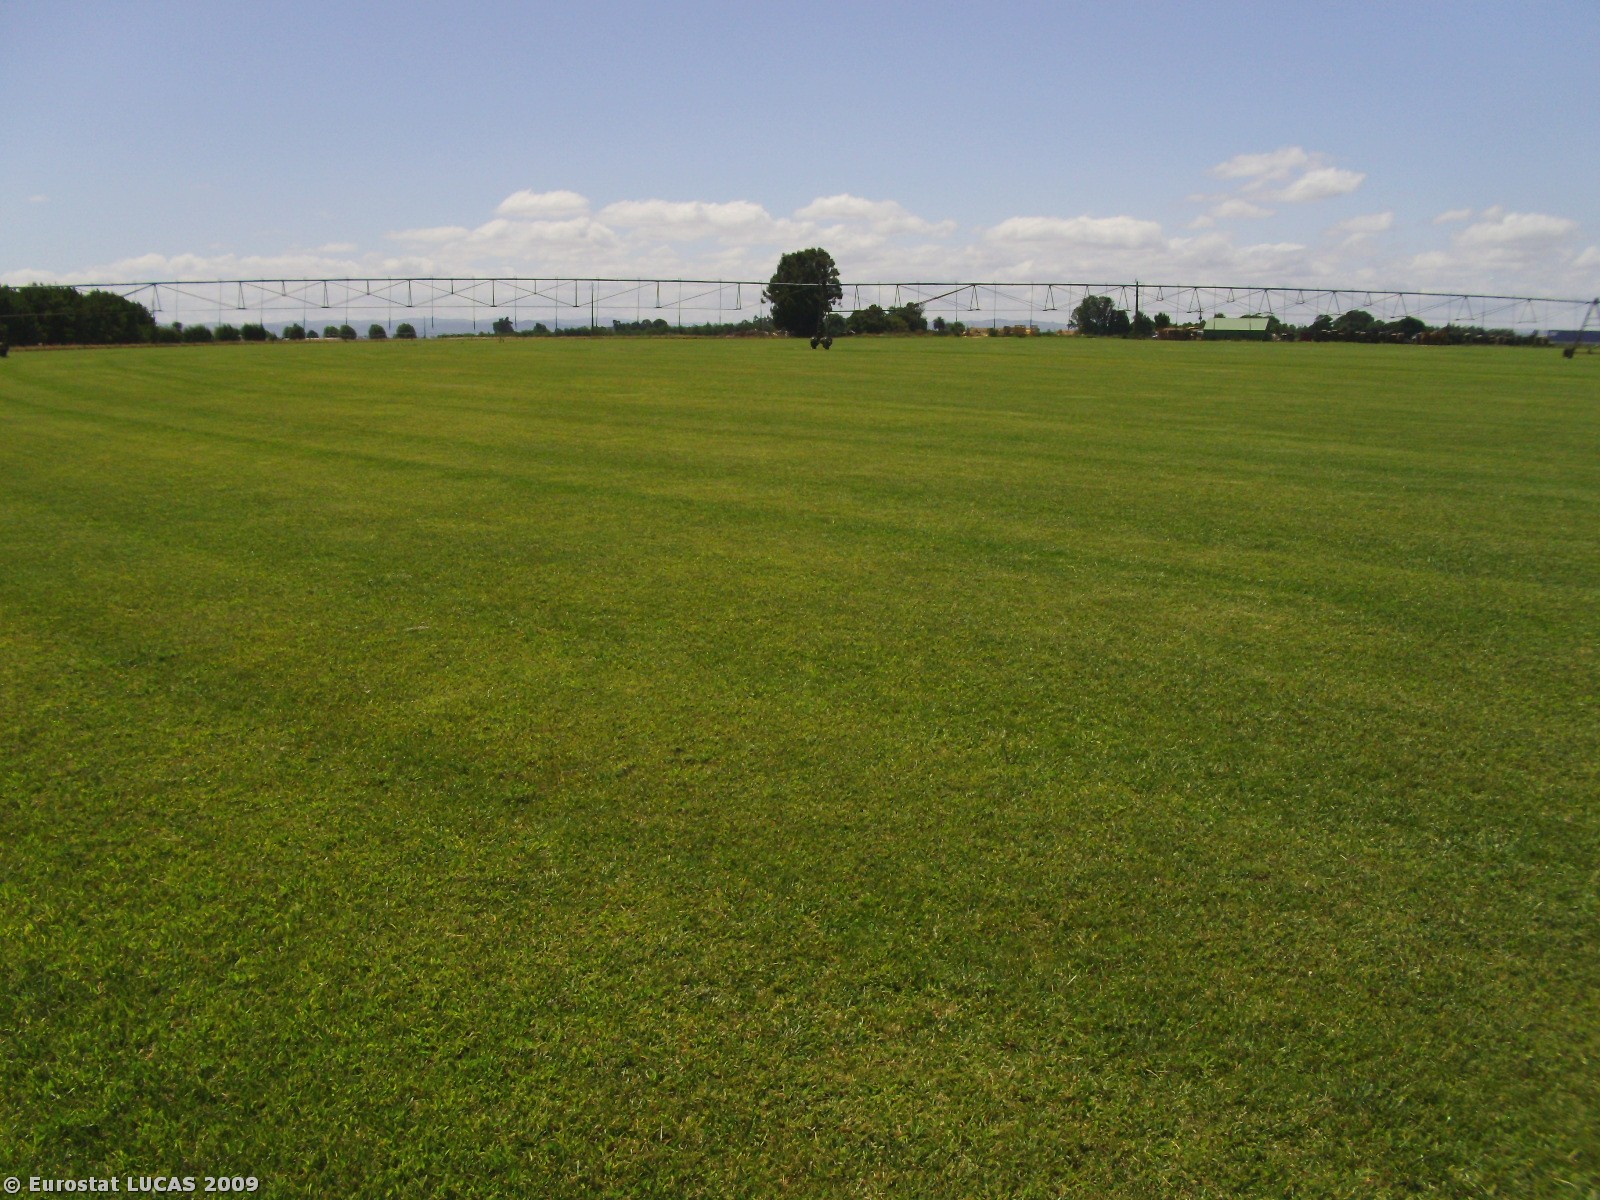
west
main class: Cropland
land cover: Temporary grasslands
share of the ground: > 75 %
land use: Agriculture (excluding fallow land and kitchen gardens)
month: July
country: PT
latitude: 39.0073
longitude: -8.7901
